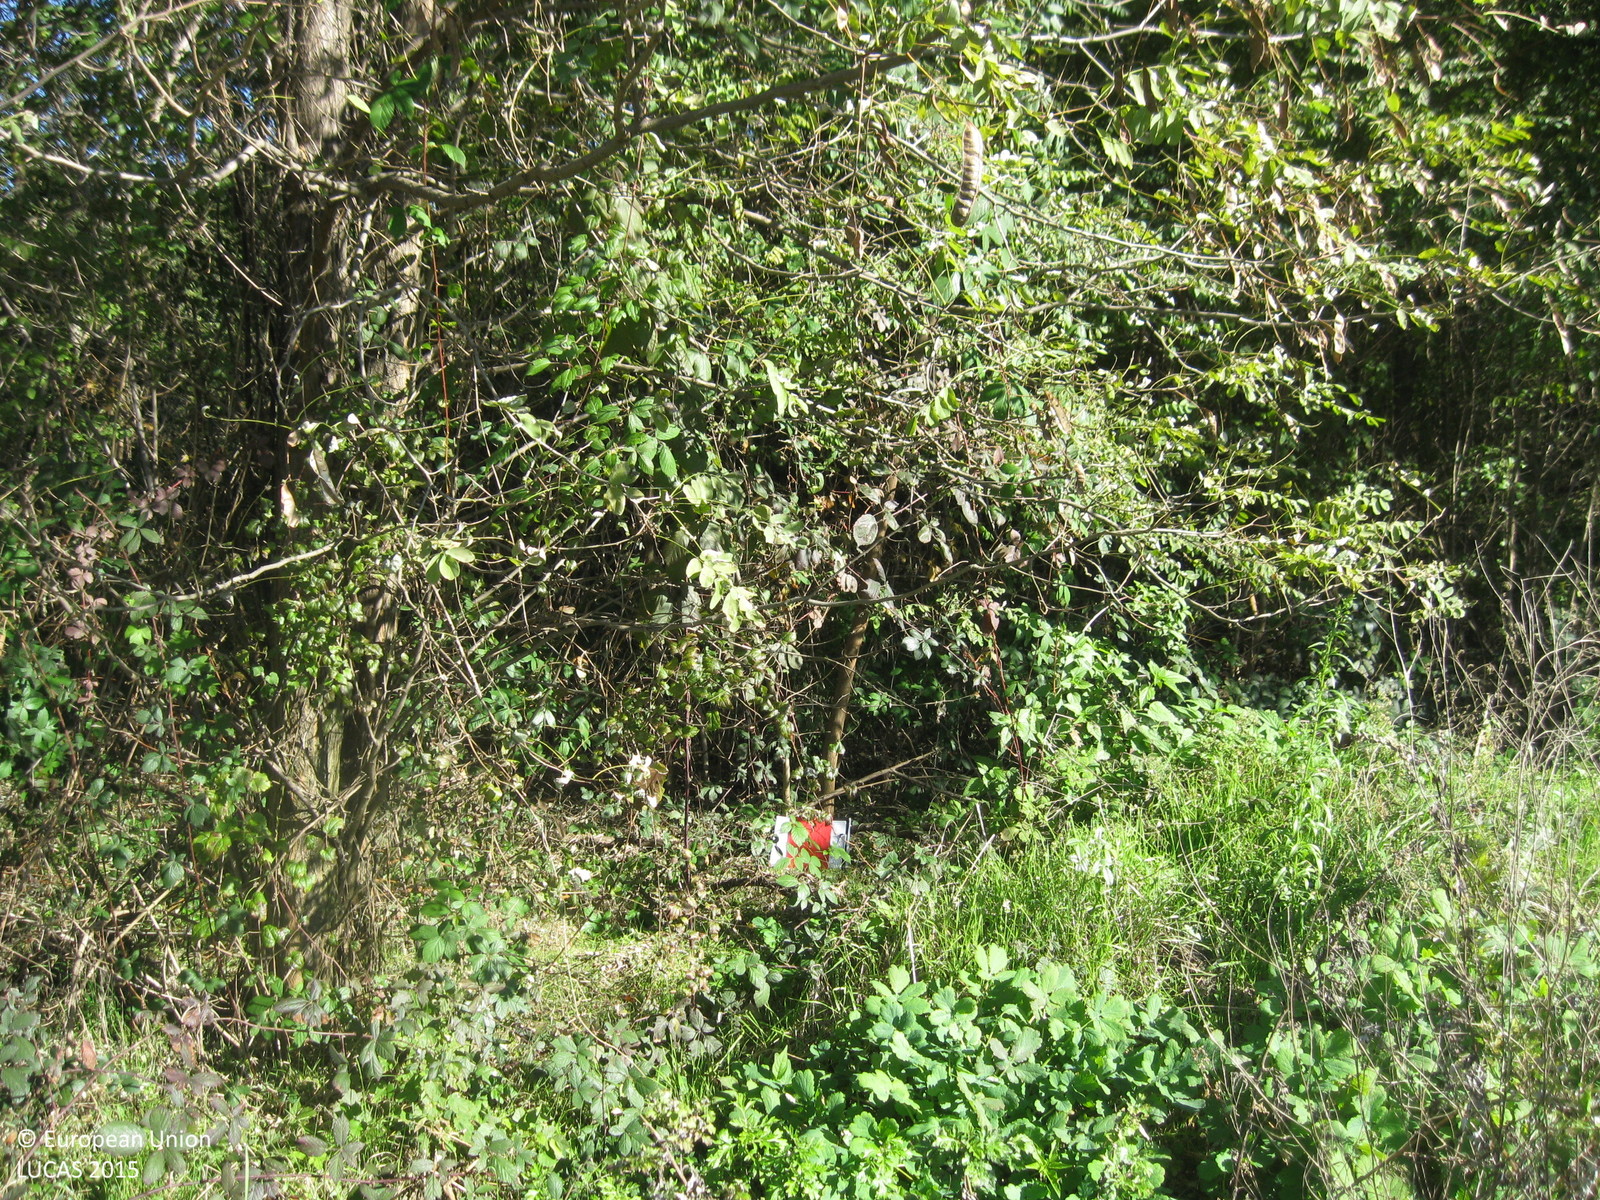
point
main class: Woodland
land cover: Broadleaved woodland
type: floodplain forest
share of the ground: > 75 %
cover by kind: broadleaved forest trees 90 %, shrubs 10 %
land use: Semi-natural and natural areas not in use
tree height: > 5 m
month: November
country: BG
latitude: 42.3835
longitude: 24.0465
